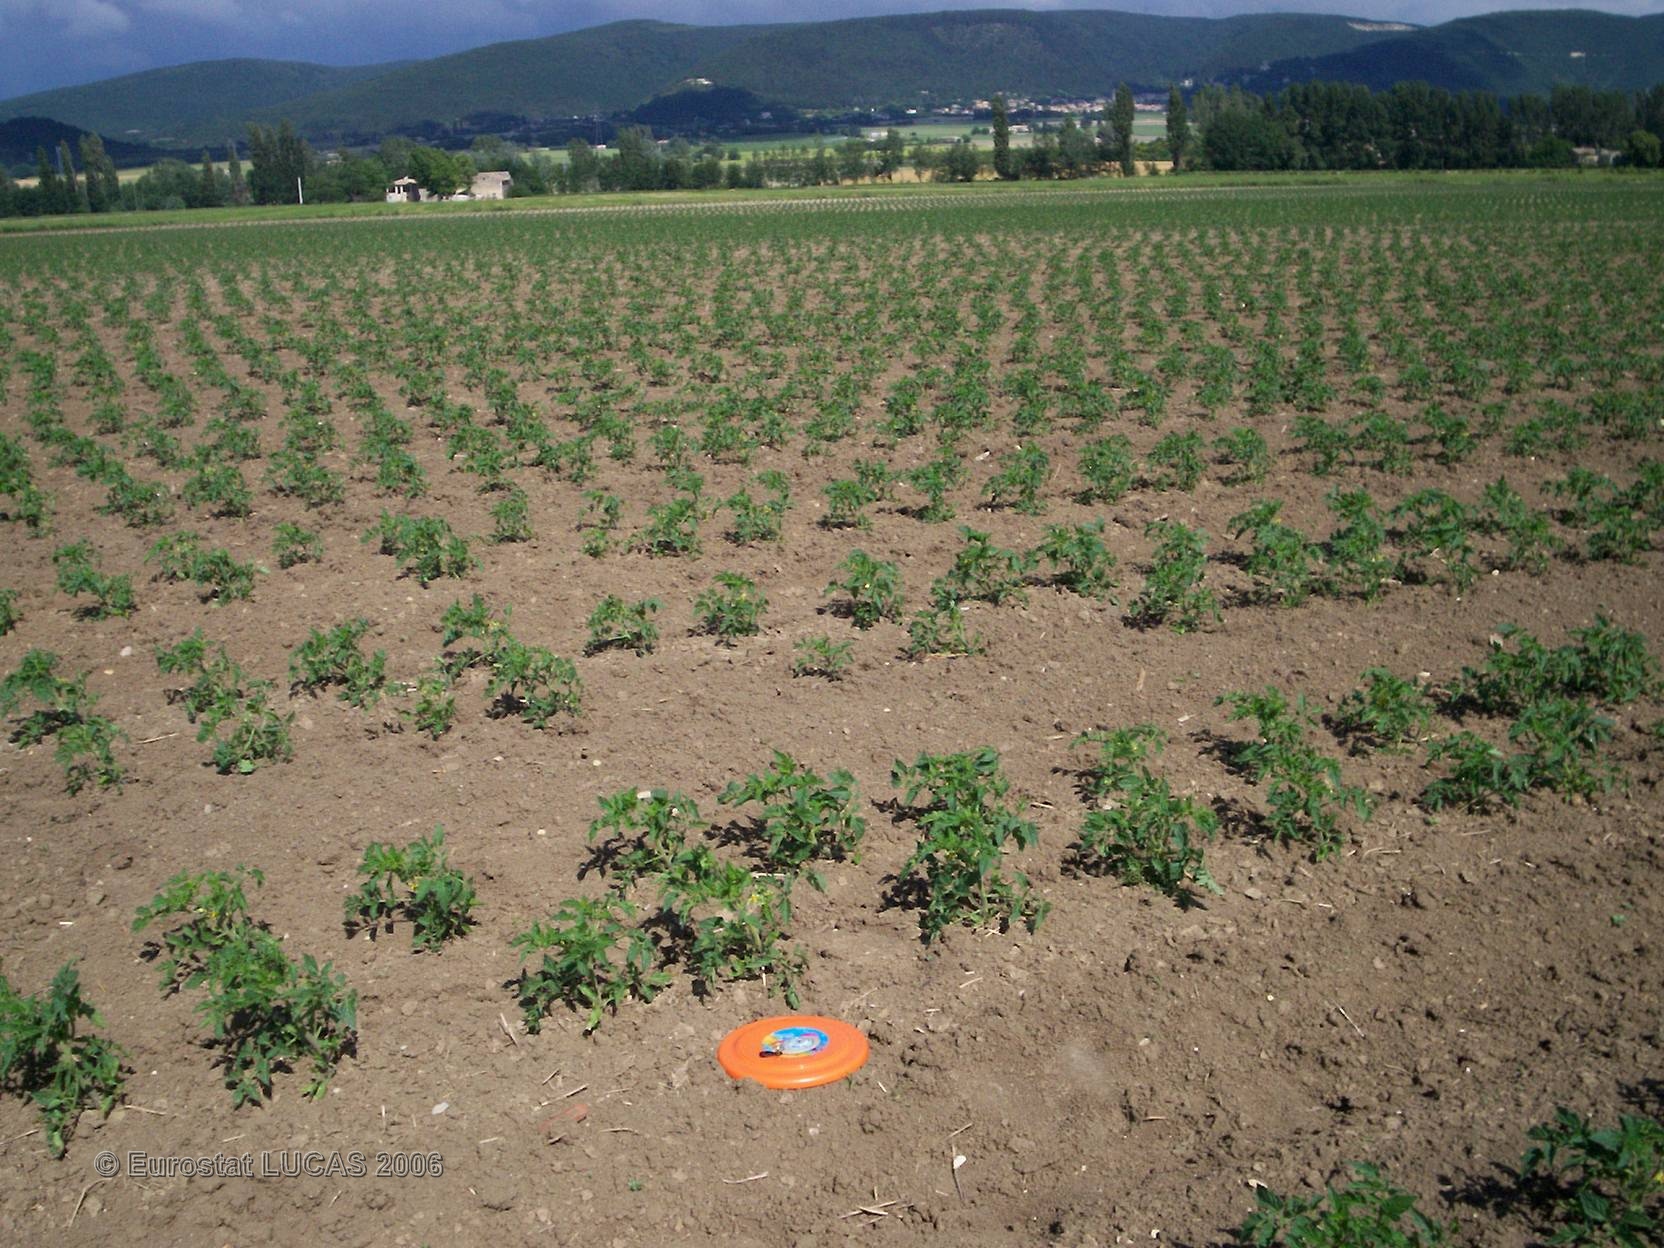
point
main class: Cropland
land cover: Tomatoes
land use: Agriculture (excluding fallow land and kitchen gardens)
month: May
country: FR
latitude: 44.6228
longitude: 4.9022
